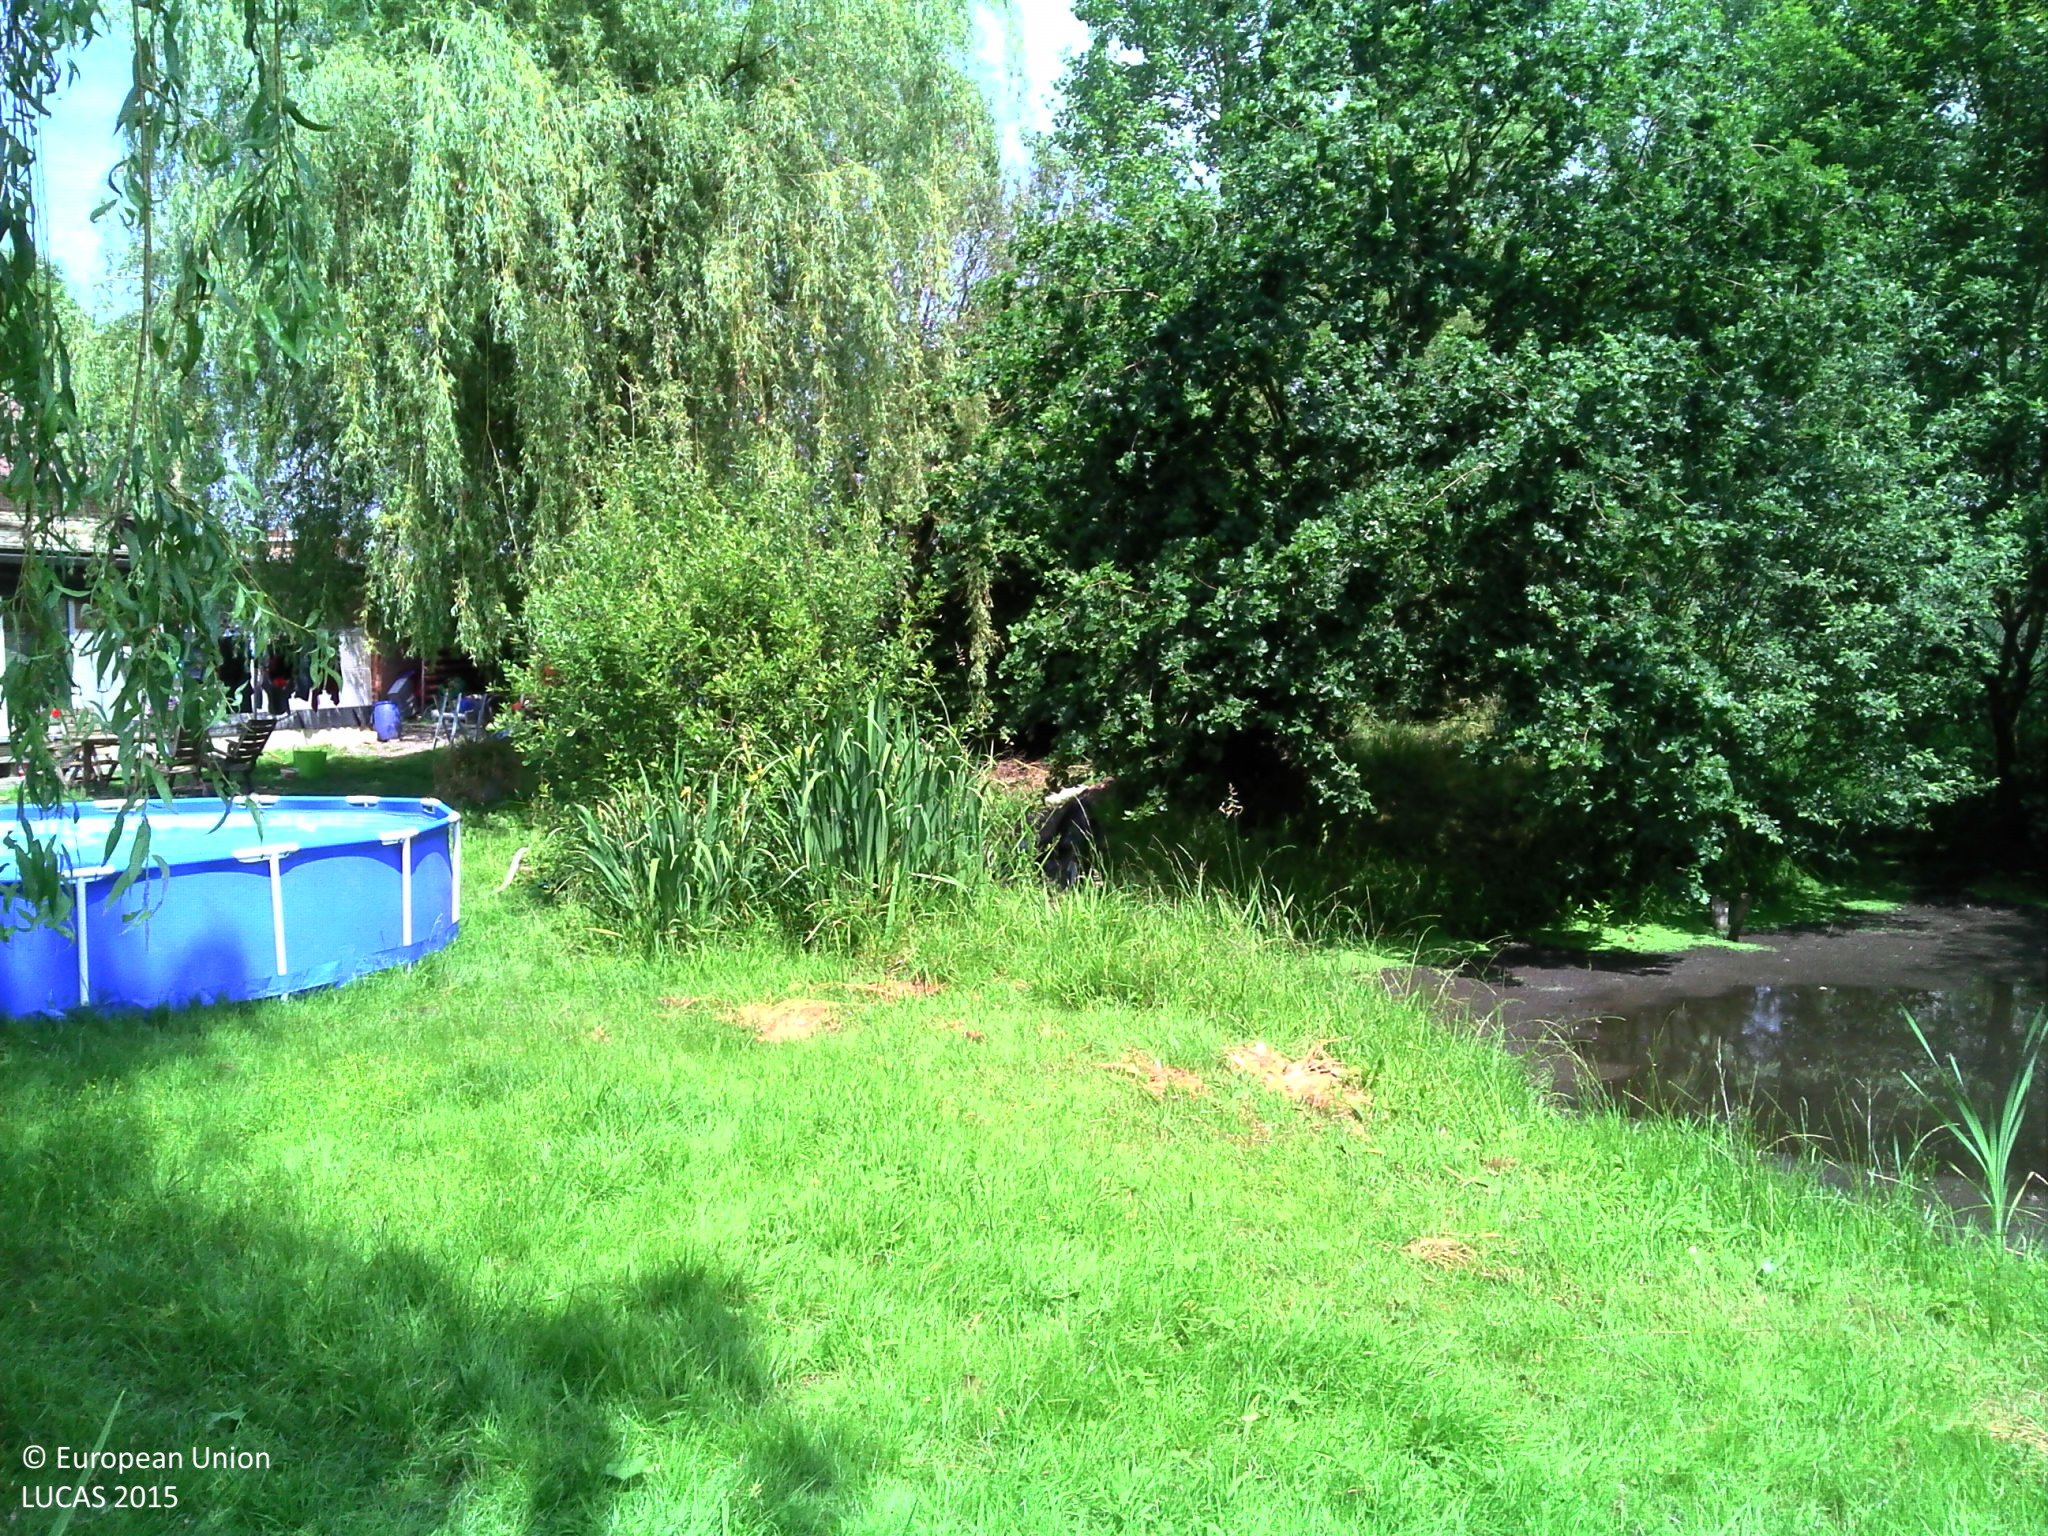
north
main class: Grassland
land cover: Grassland with sparse tree/shrub cover
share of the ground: > 75 %
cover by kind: herbaceous plants 95 %, broadleaved forest trees 5 %
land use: Residential
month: June
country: BE
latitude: 50.4623
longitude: 3.7245
